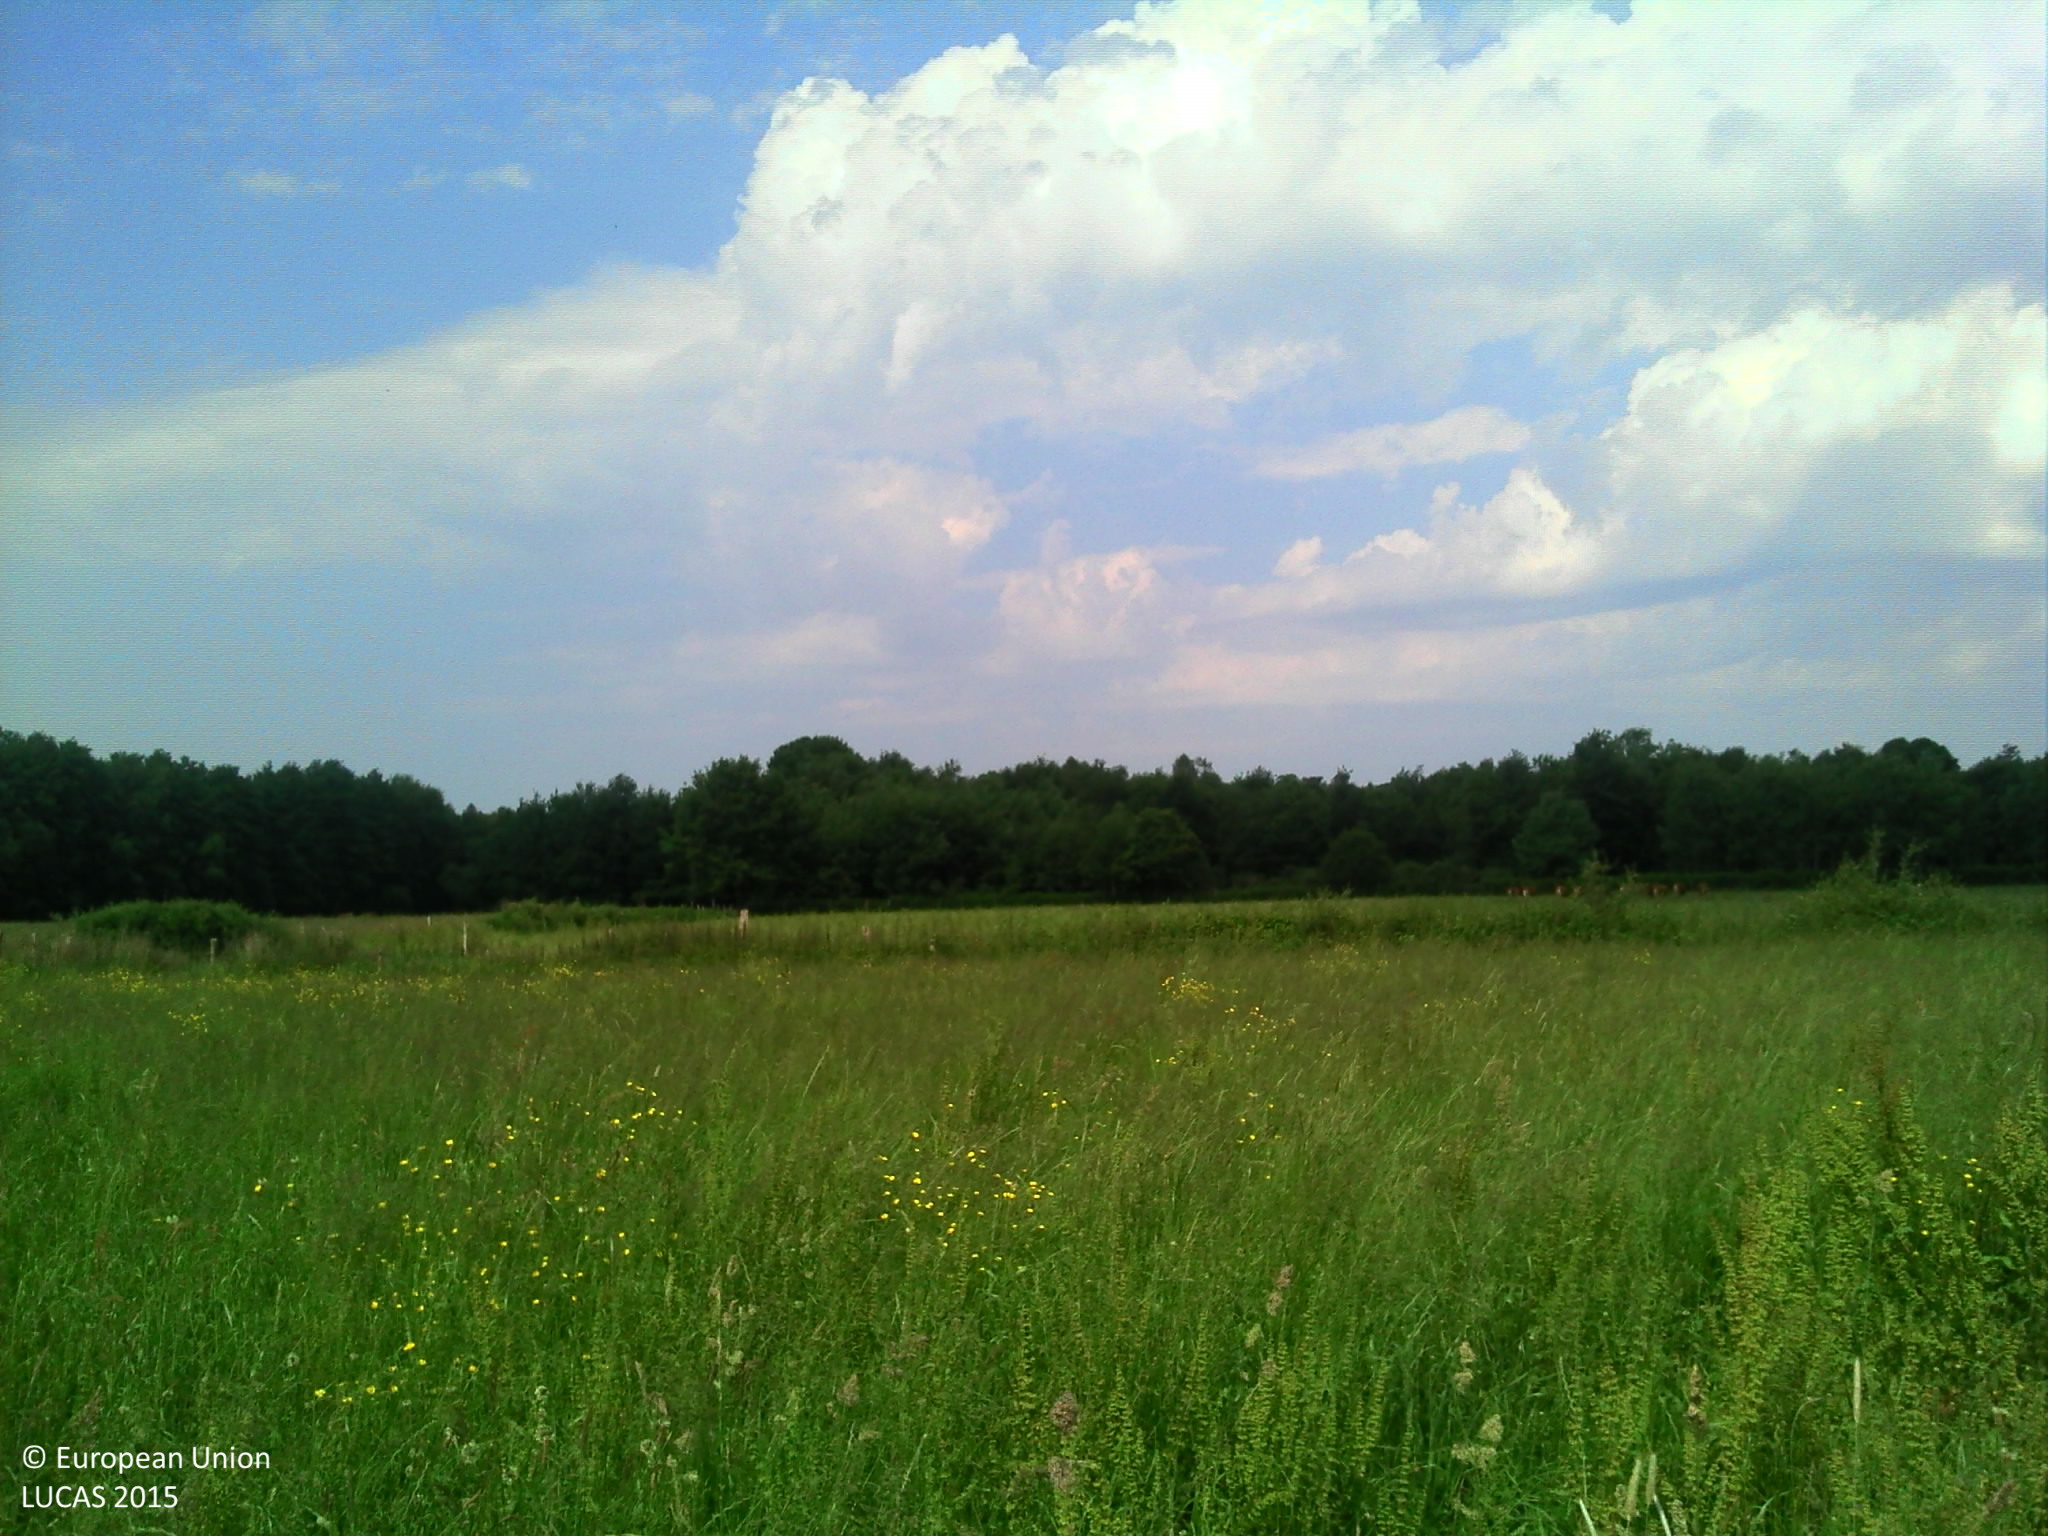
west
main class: Grassland
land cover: Grassland without tree/shrub cover
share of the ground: > 75 %
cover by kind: herbaceous plants 100 %
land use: Agriculture (excluding fallow land and kitchen gardens)
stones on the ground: < 10 %
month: June
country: FR
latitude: 47.8597
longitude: 0.0147
